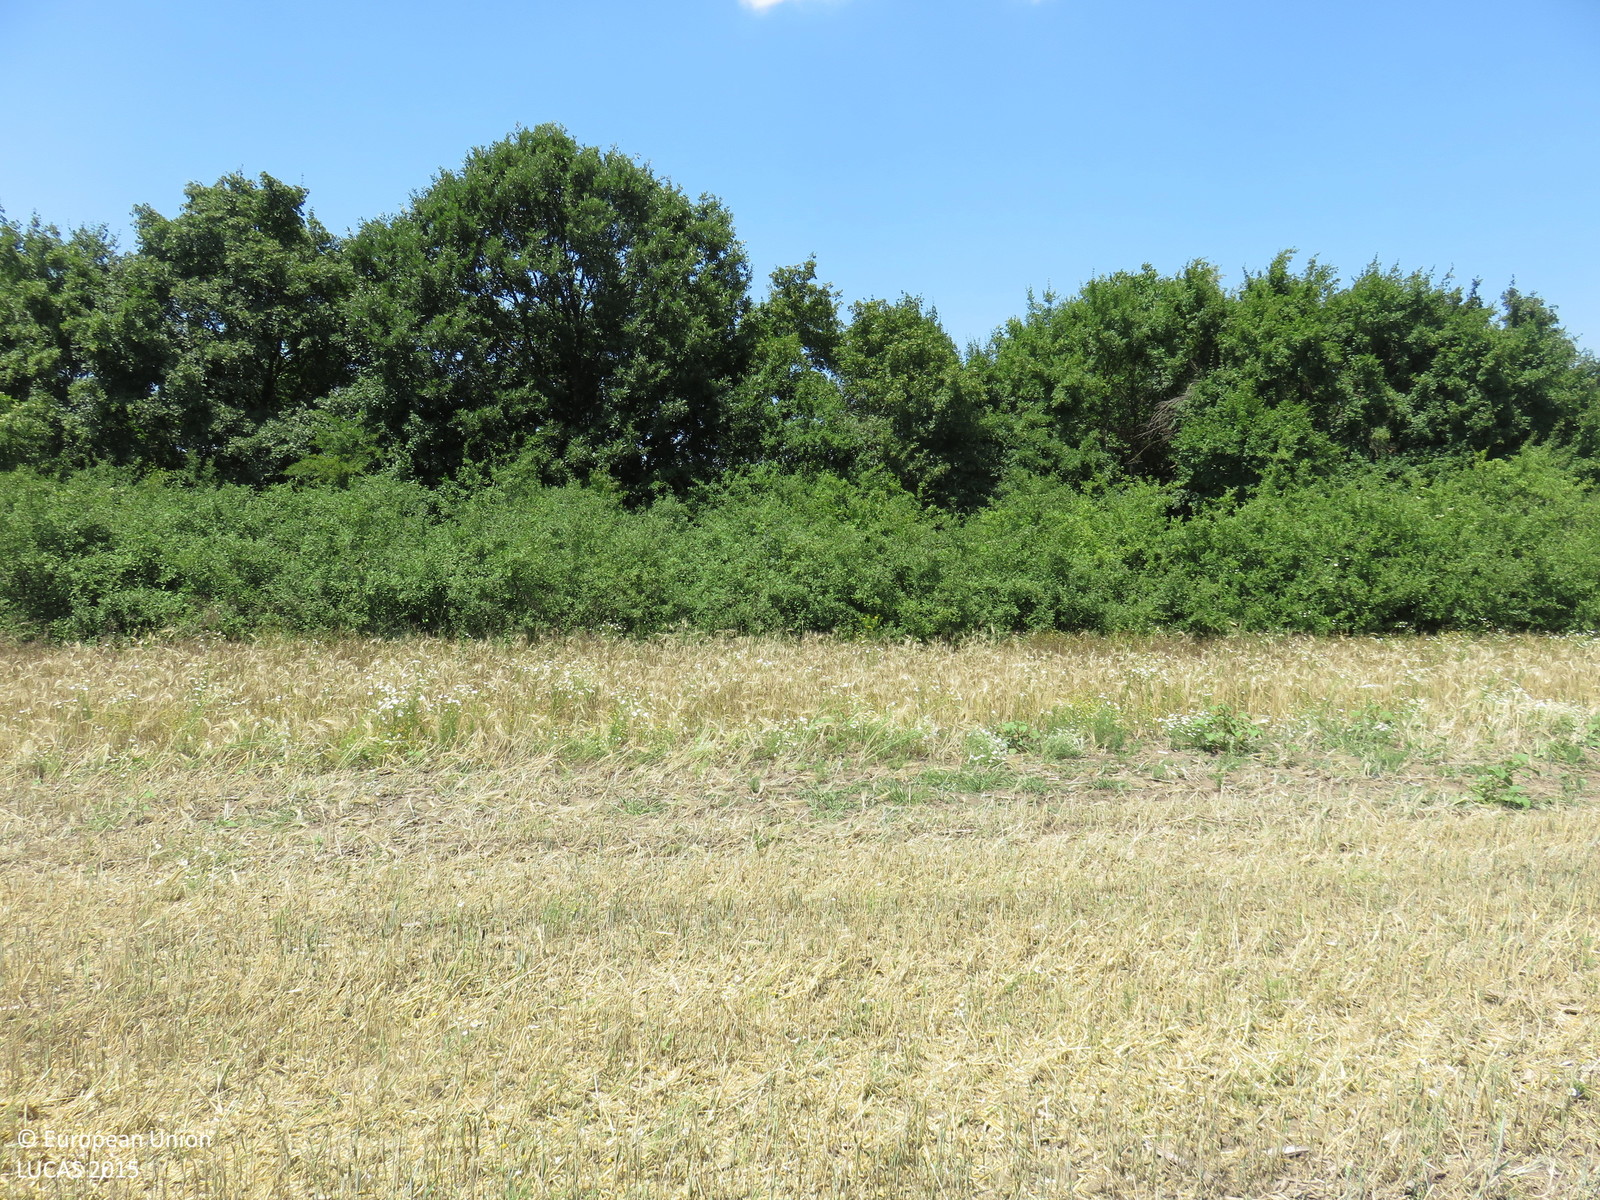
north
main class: Cropland
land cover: Barley
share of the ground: > 75 %
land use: Agriculture (excluding fallow land and kitchen gardens)
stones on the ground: < 10 %
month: June
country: BG
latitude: 43.2588
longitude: 24.8354
